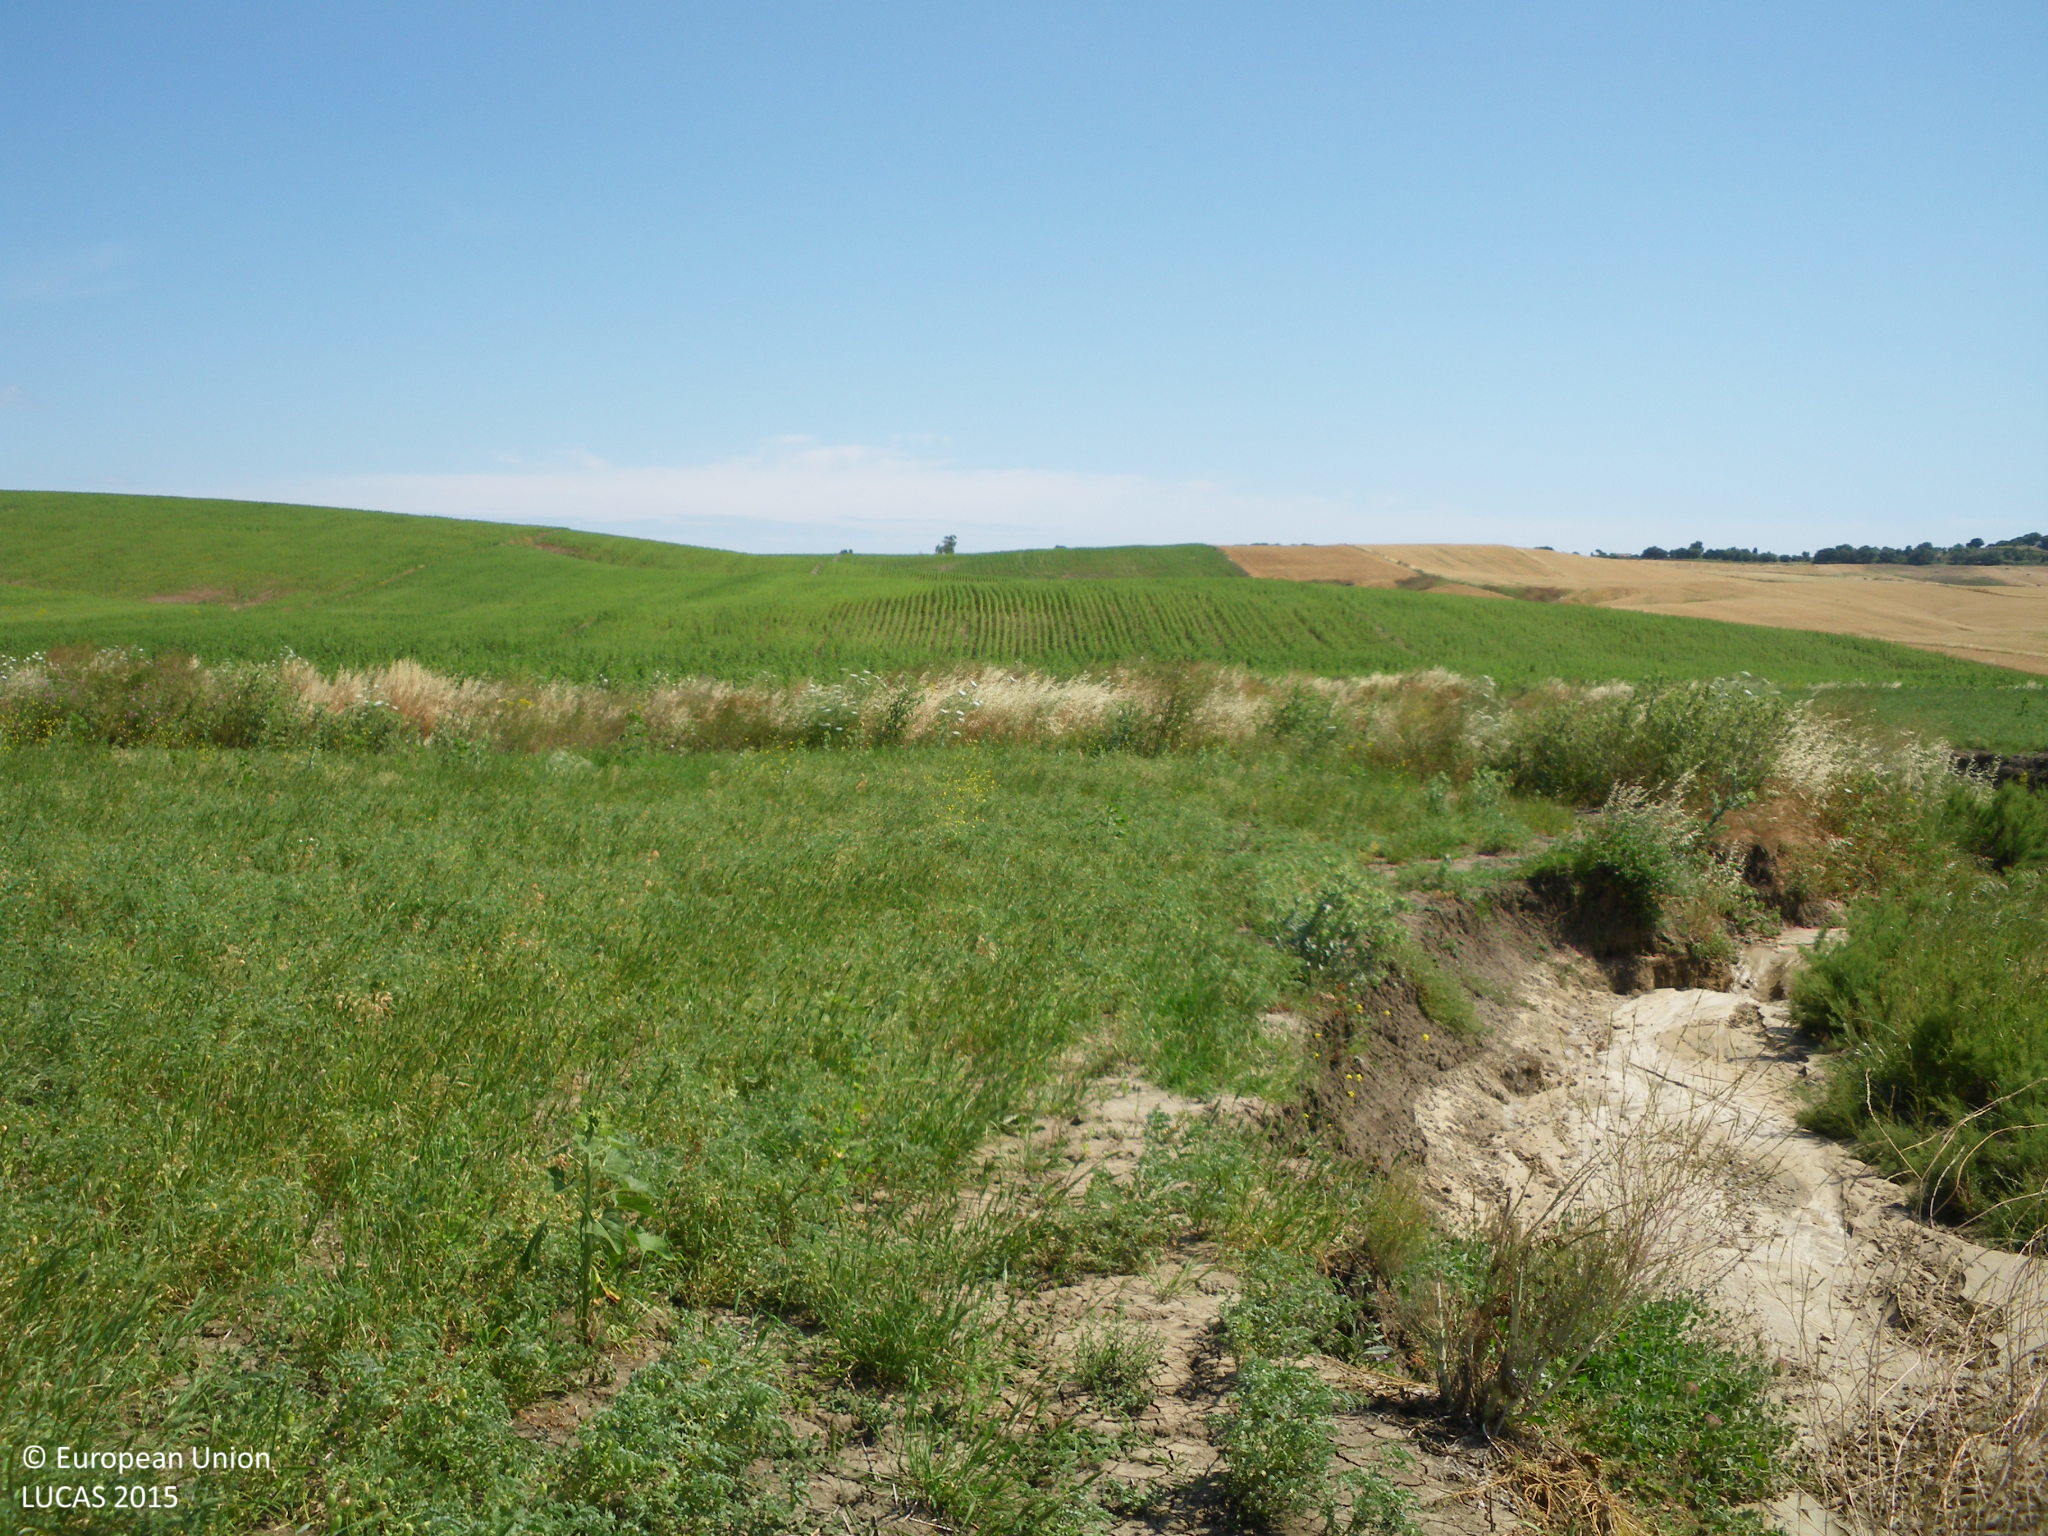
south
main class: Cropland
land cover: Dry pulses
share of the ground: 50 - 75 %
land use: Agriculture (excluding fallow land and kitchen gardens)
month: May
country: ES
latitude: 36.3234
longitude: -5.9193
